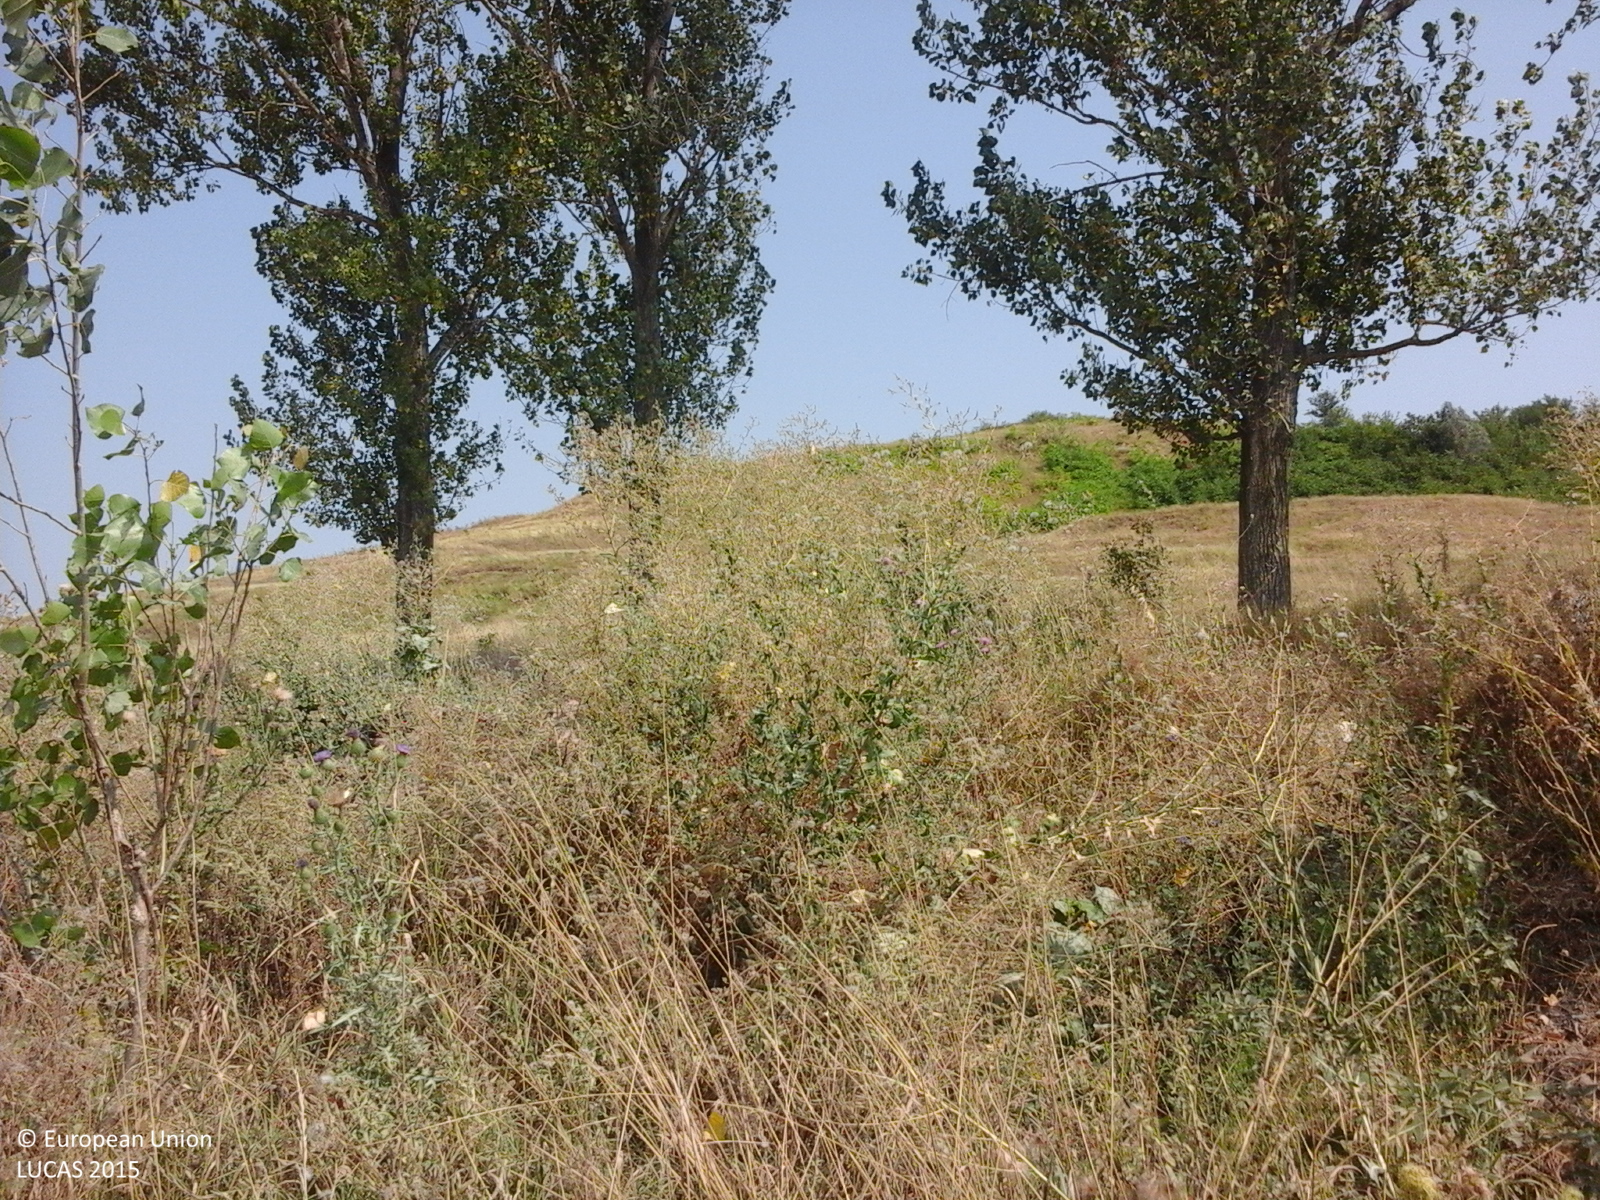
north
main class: Grassland
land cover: Spontaneously vegetated surfaces
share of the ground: > 75 %
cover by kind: herbaceous plants 100 %
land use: Fallow land
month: August
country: RO
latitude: 44.3842
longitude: 23.4446
